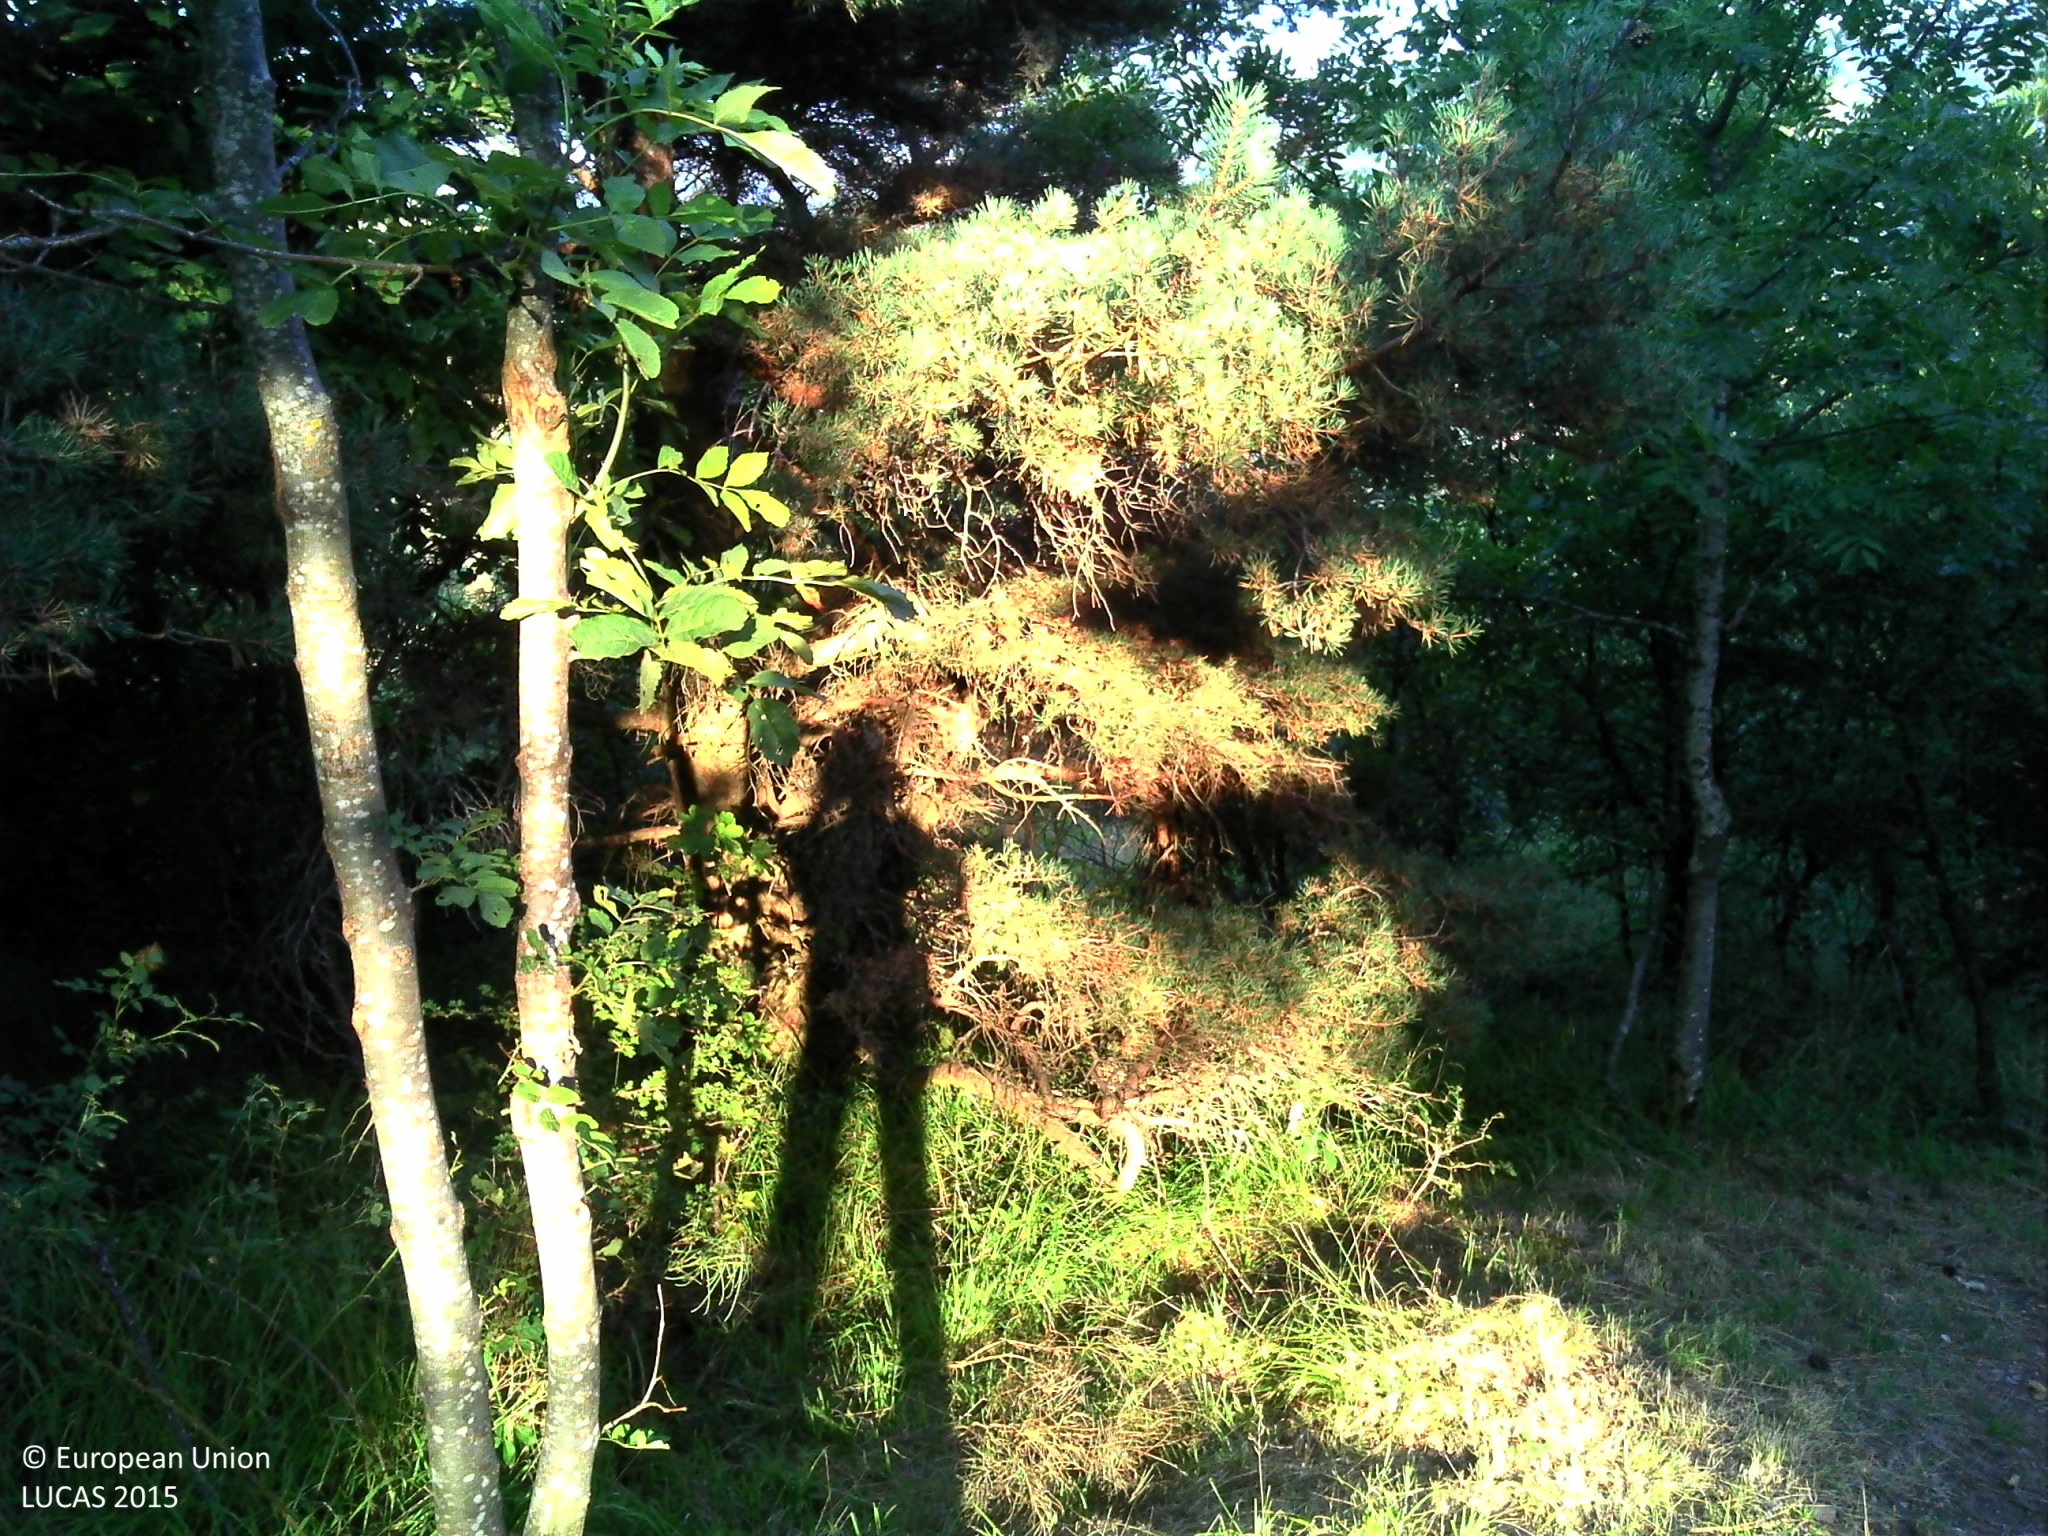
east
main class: Woodland
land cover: Pine dominated mixed woodland
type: hemiboreal forest and nemoral coniferous forest and mixed broadleaved-coniferous forest
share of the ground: > 75 %
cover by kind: herbaceous plants 60 %, coniferous forest trees 20 %, broadleaved forest trees 15 %, lichens and mosses 5 %
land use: Semi-natural and natural areas not in use
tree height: > 5 m
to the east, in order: Pine dominated mixed woodland; Tracks; Electric lines; Pine dominated mixed woodland; Tracks; Fences; Shrubland with sparse tree cover; Fences; Grassland without tree/shrub cover
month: August
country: FR
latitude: 45.4164
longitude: 4.5220
